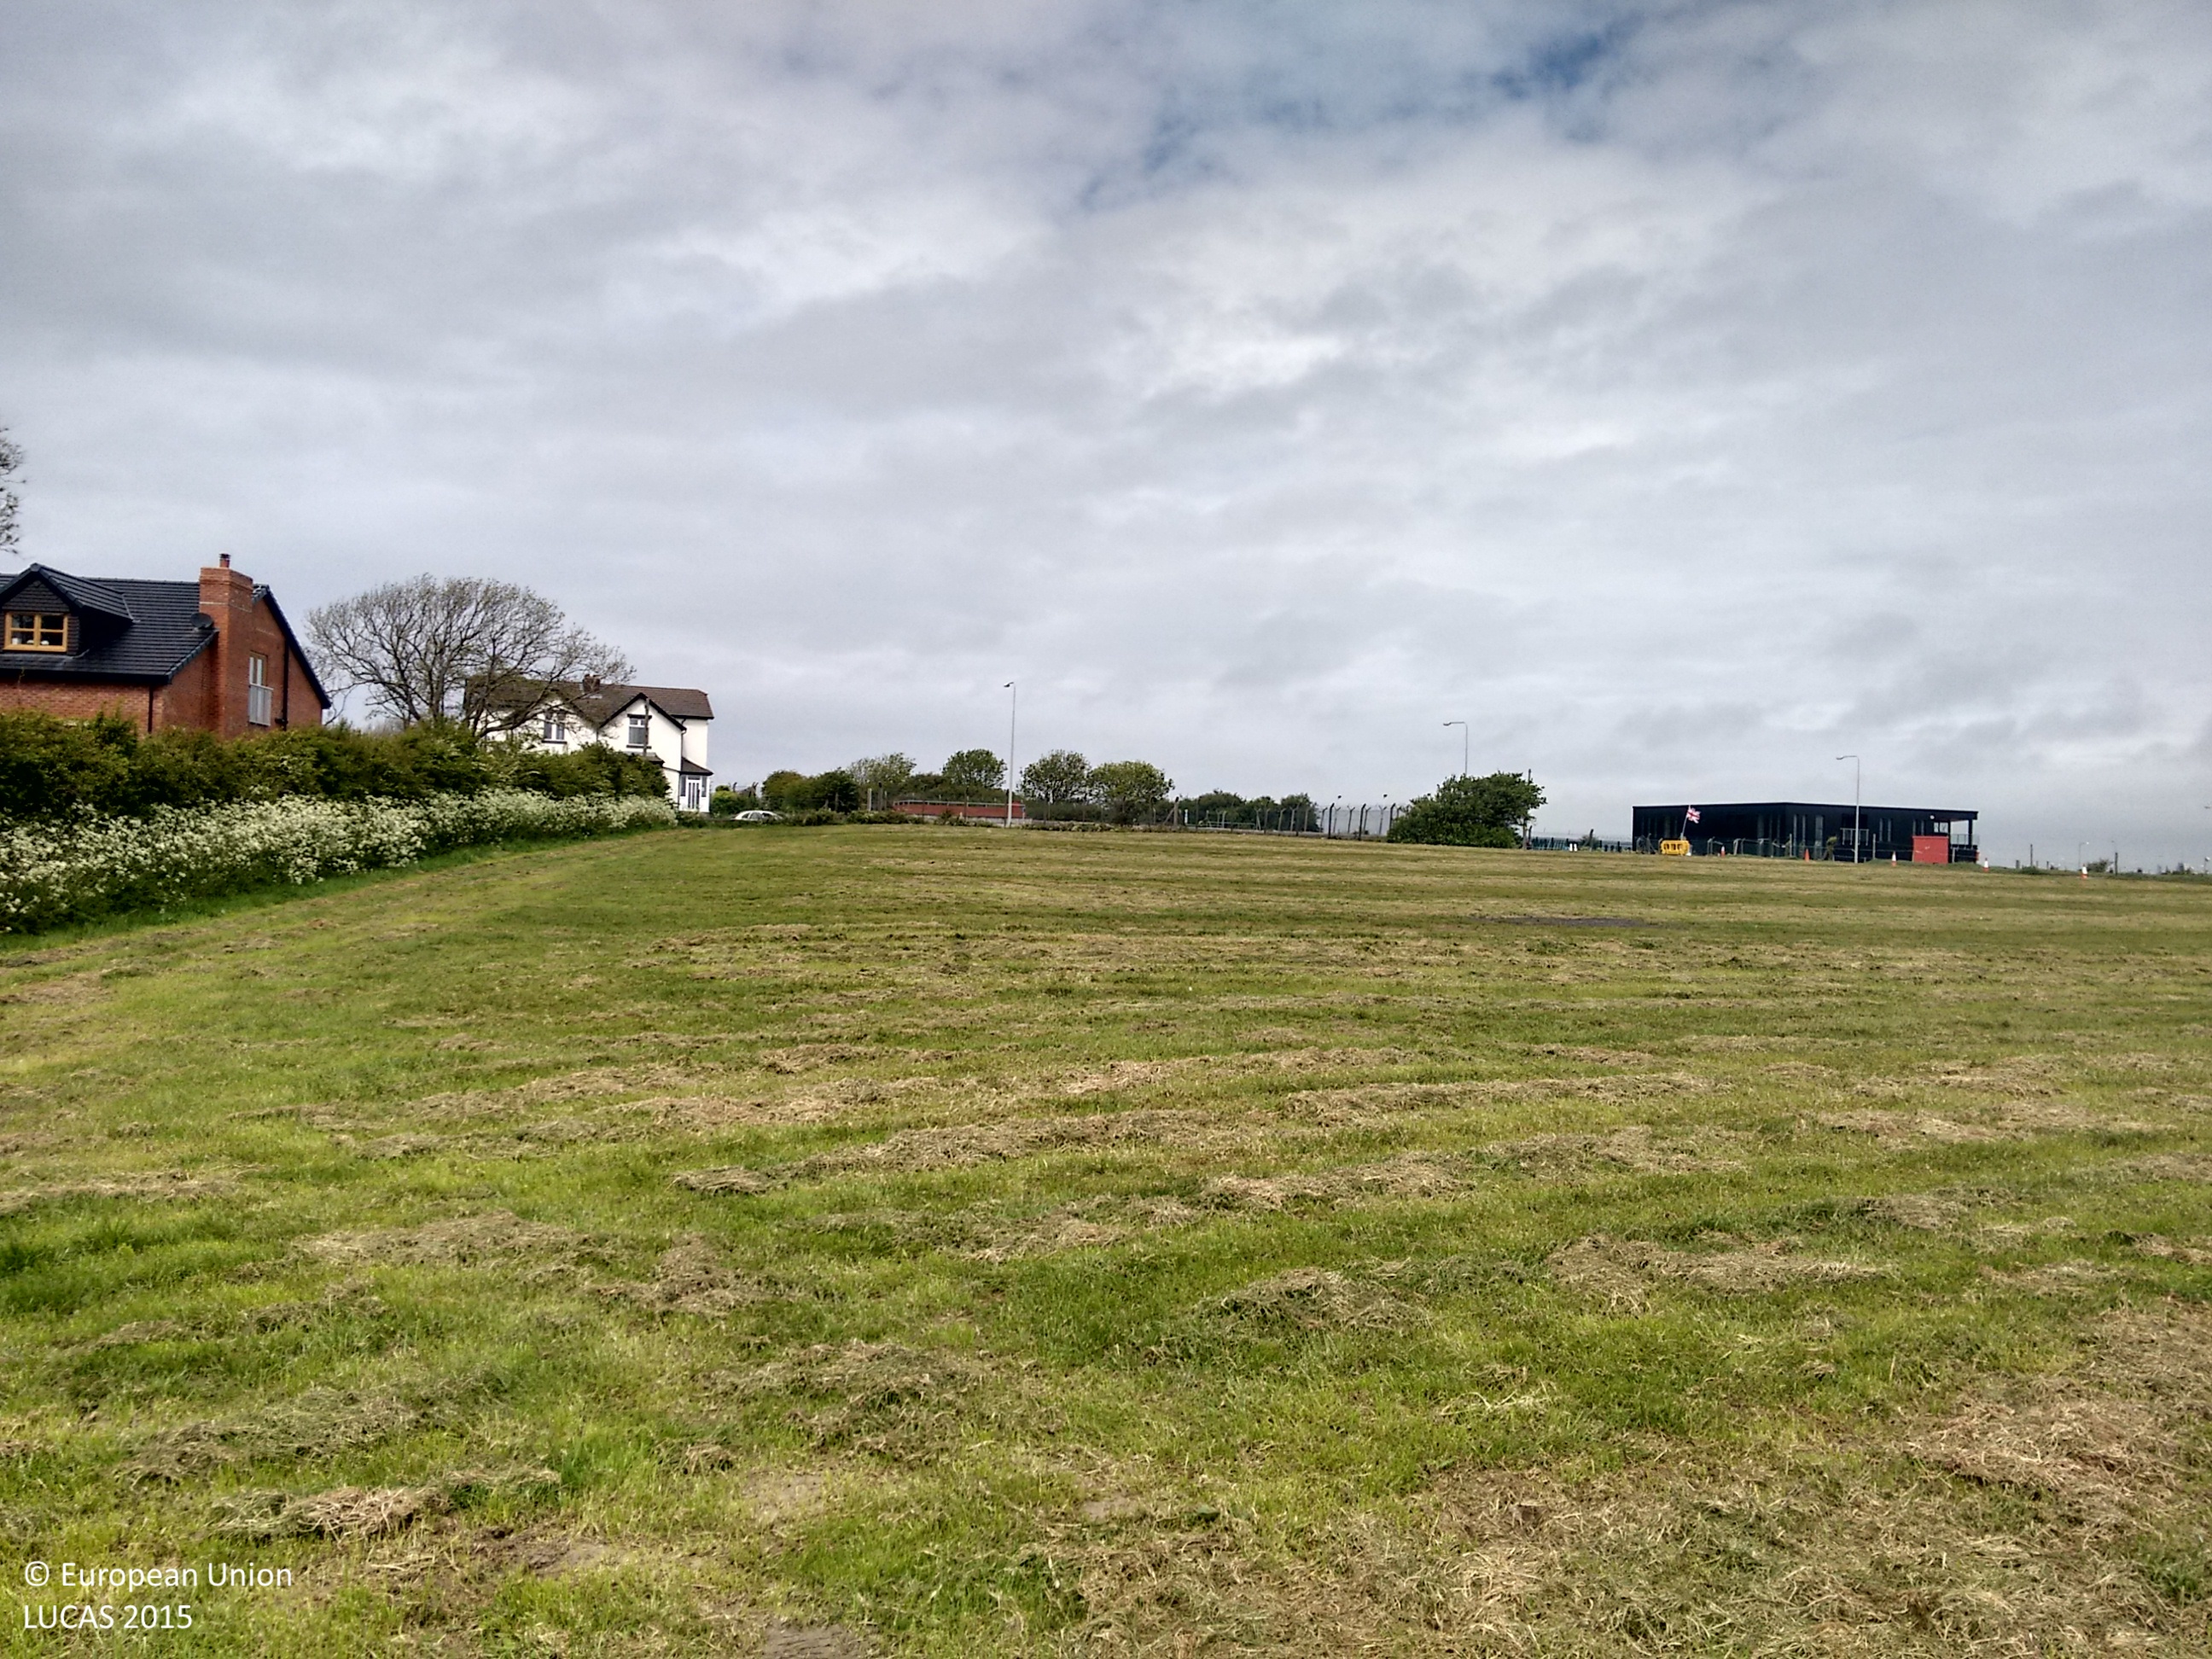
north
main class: Grassland
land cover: Grassland without tree/shrub cover
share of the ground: > 75 %
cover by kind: herbaceous plants 100 %
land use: Agriculture (excluding fallow land and kitchen gardens)
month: May
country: GB
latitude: 53.8622
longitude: -3.0137
